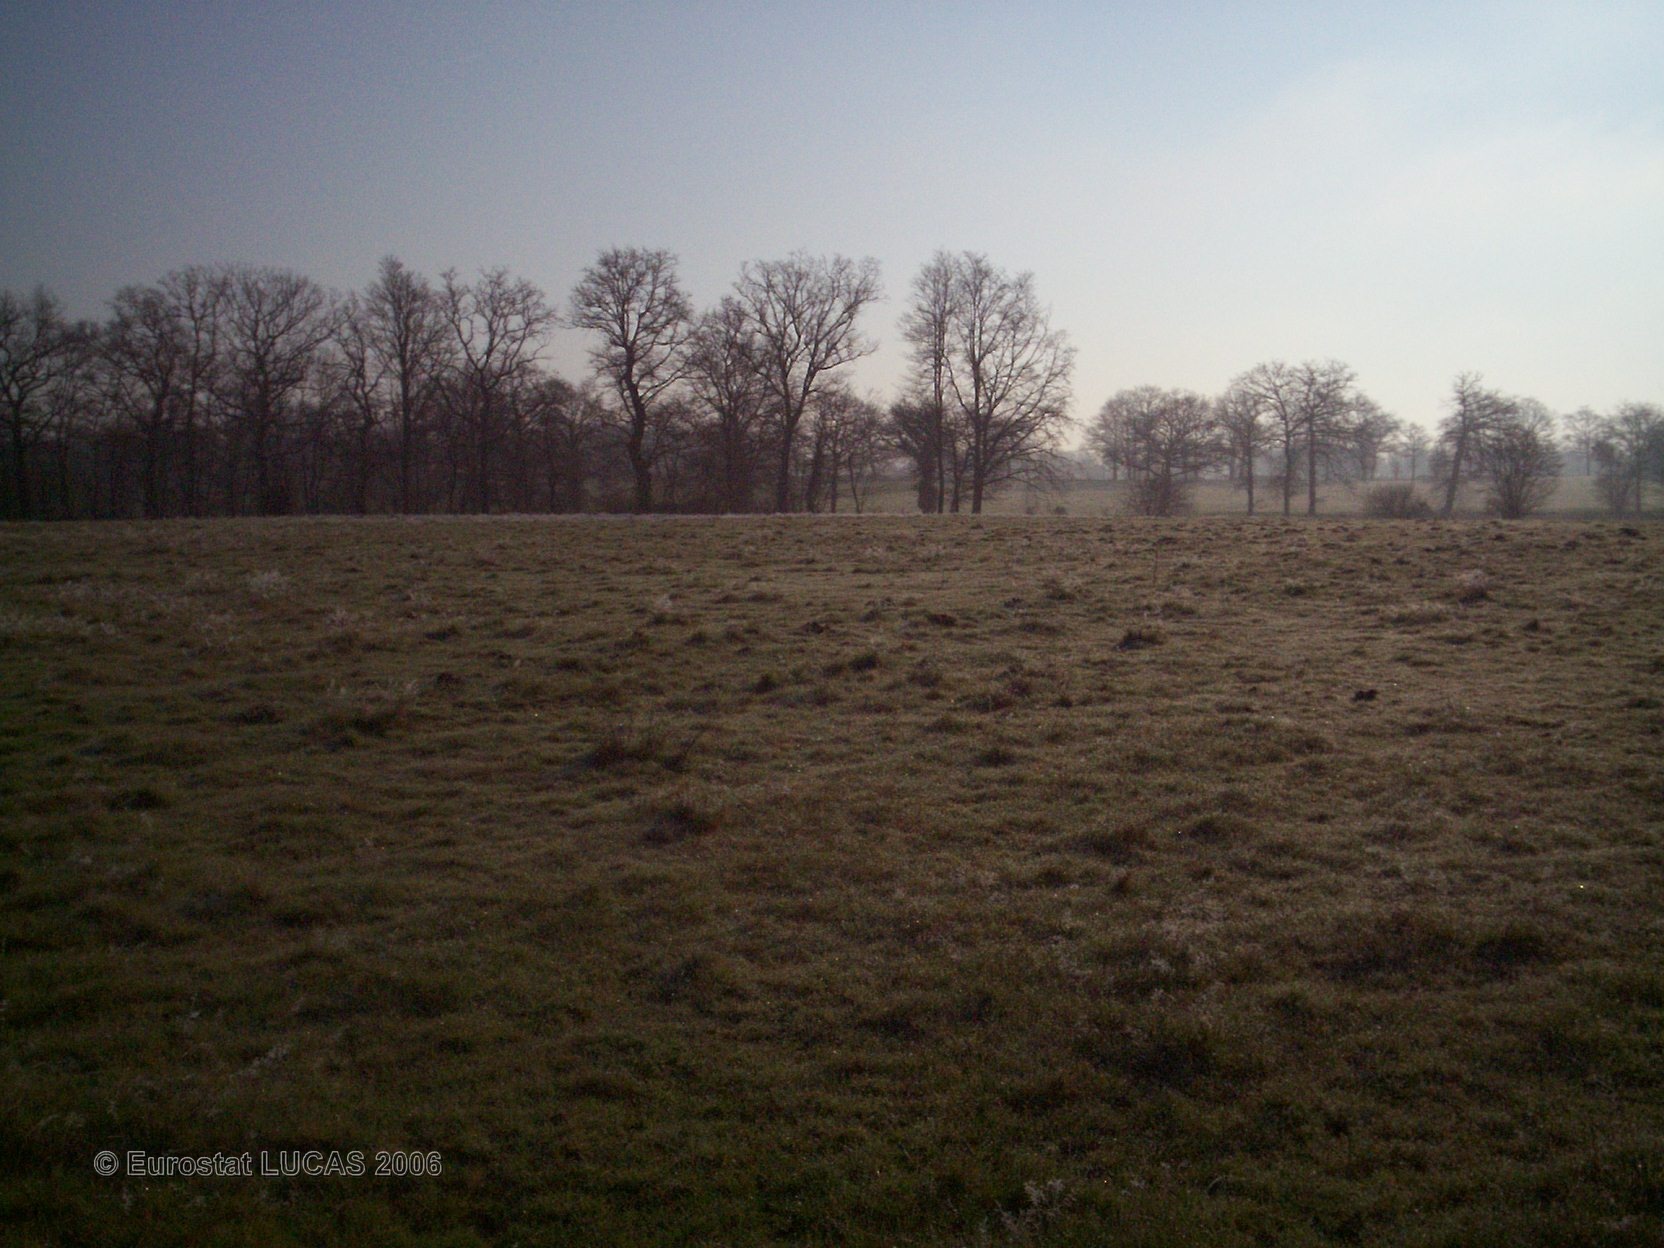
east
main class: Grassland
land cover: Grassland without tree/shrub cover
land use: Agriculture (excluding fallow land and kitchen gardens)
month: April
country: FR
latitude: 46.2516
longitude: 1.1027
